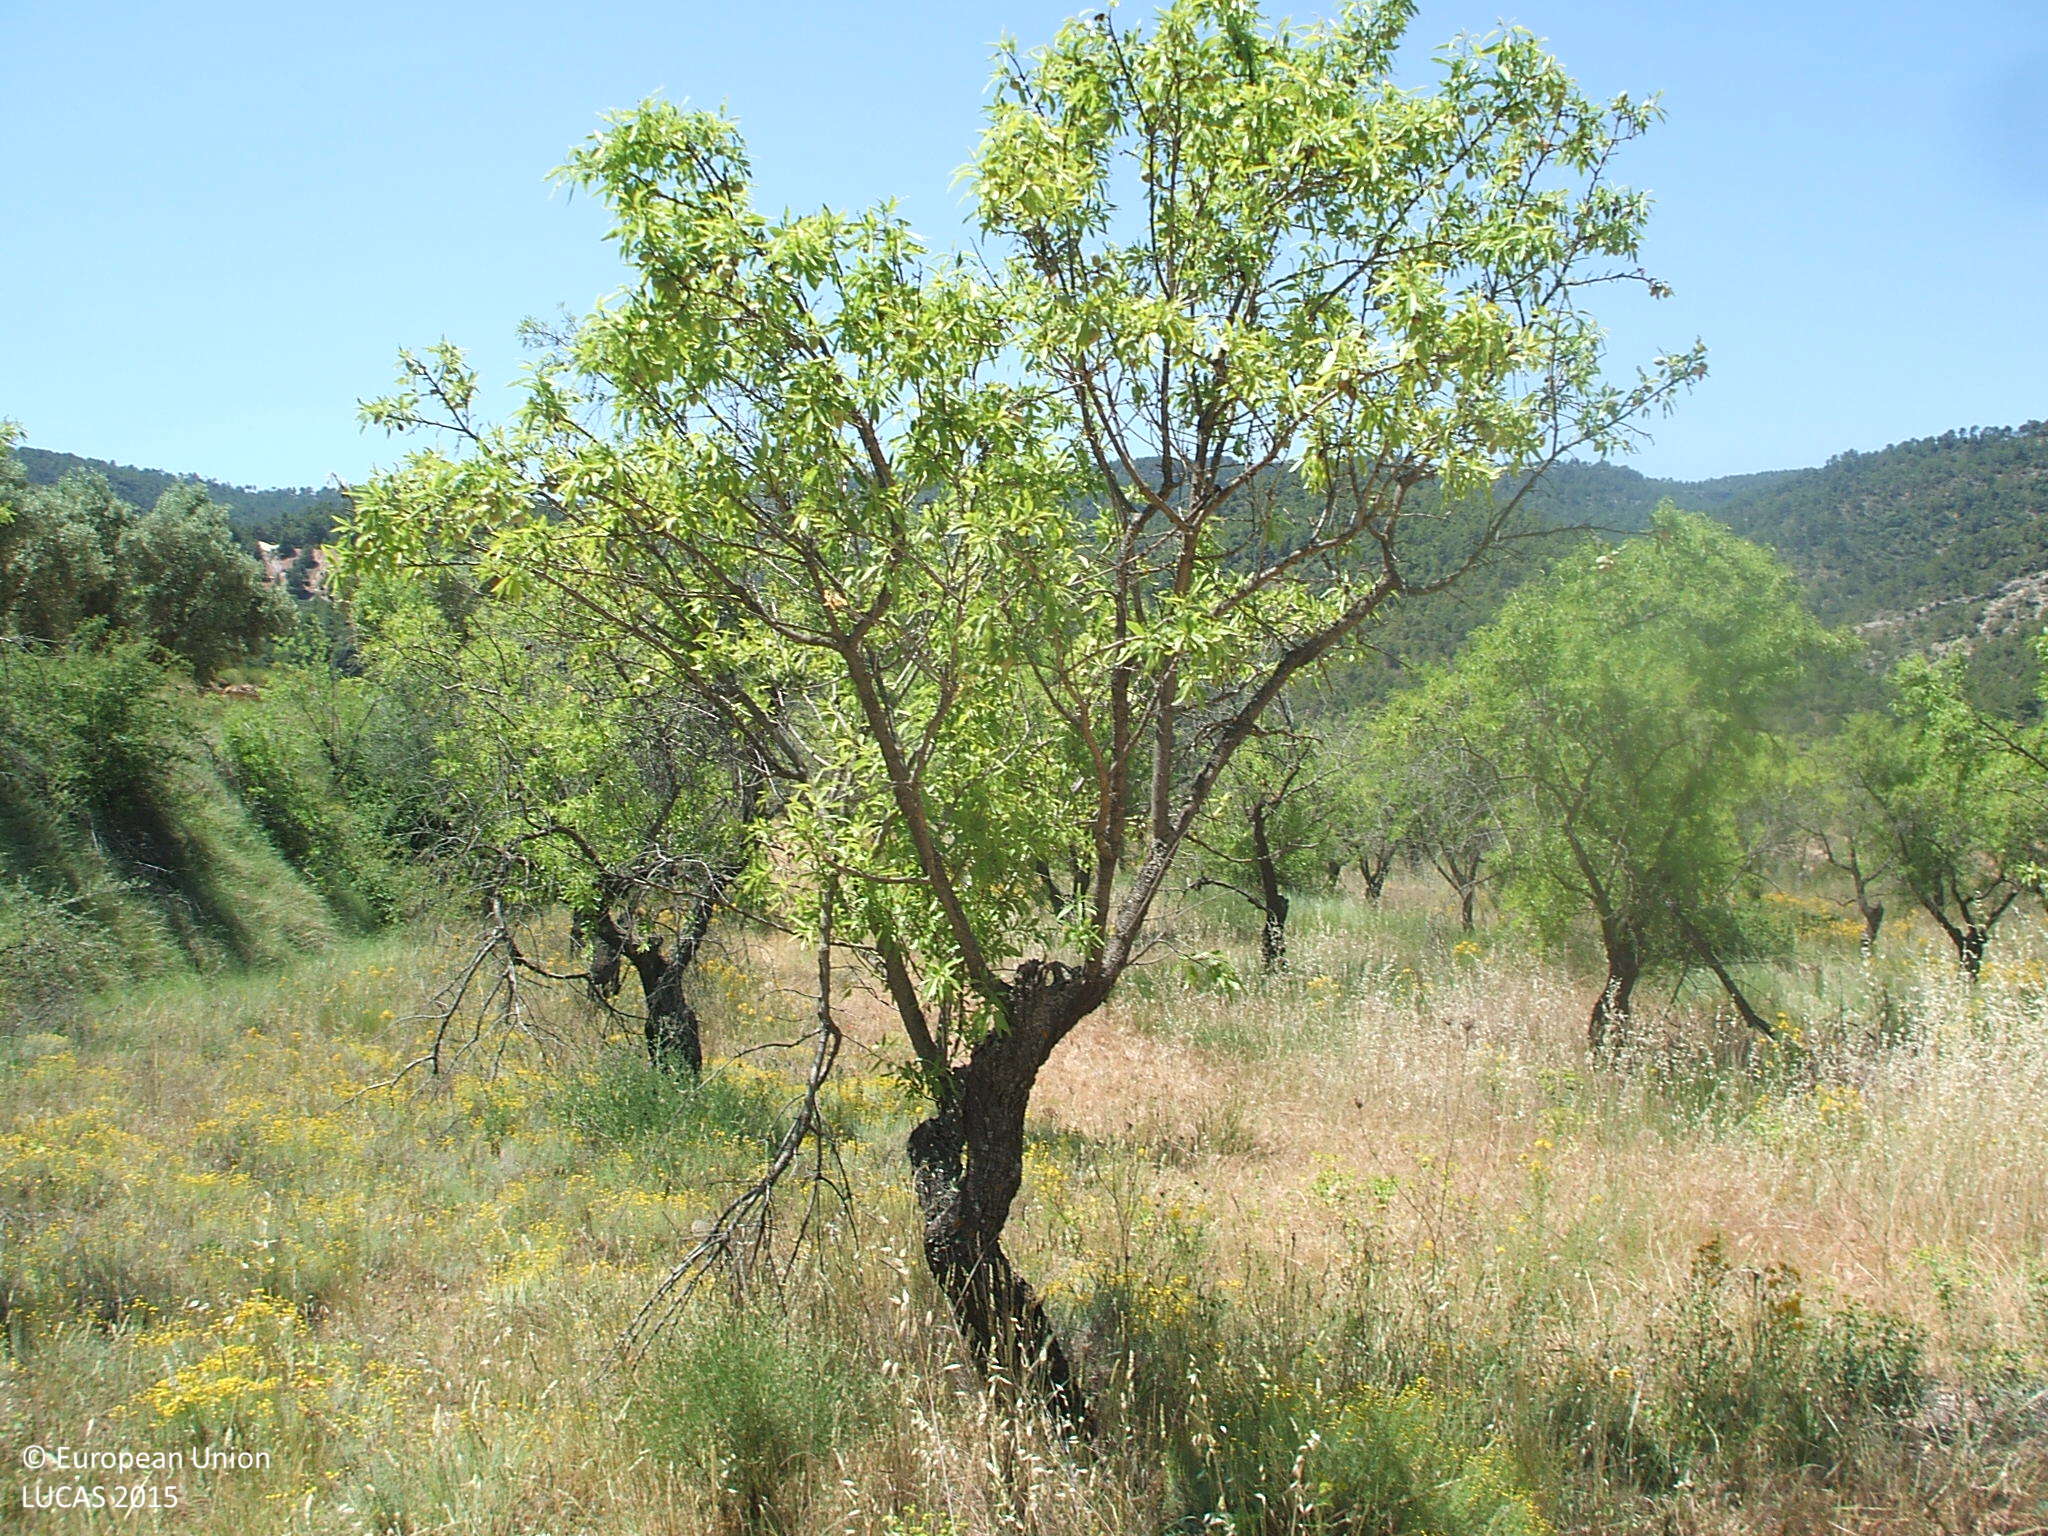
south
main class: Cropland
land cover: Olive groves
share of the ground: 10 - 25 %
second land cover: Other bare soil
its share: > 75 %
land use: Agriculture (excluding fallow land and kitchen gardens)
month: June
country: ES
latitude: 40.8316
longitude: 0.0185
